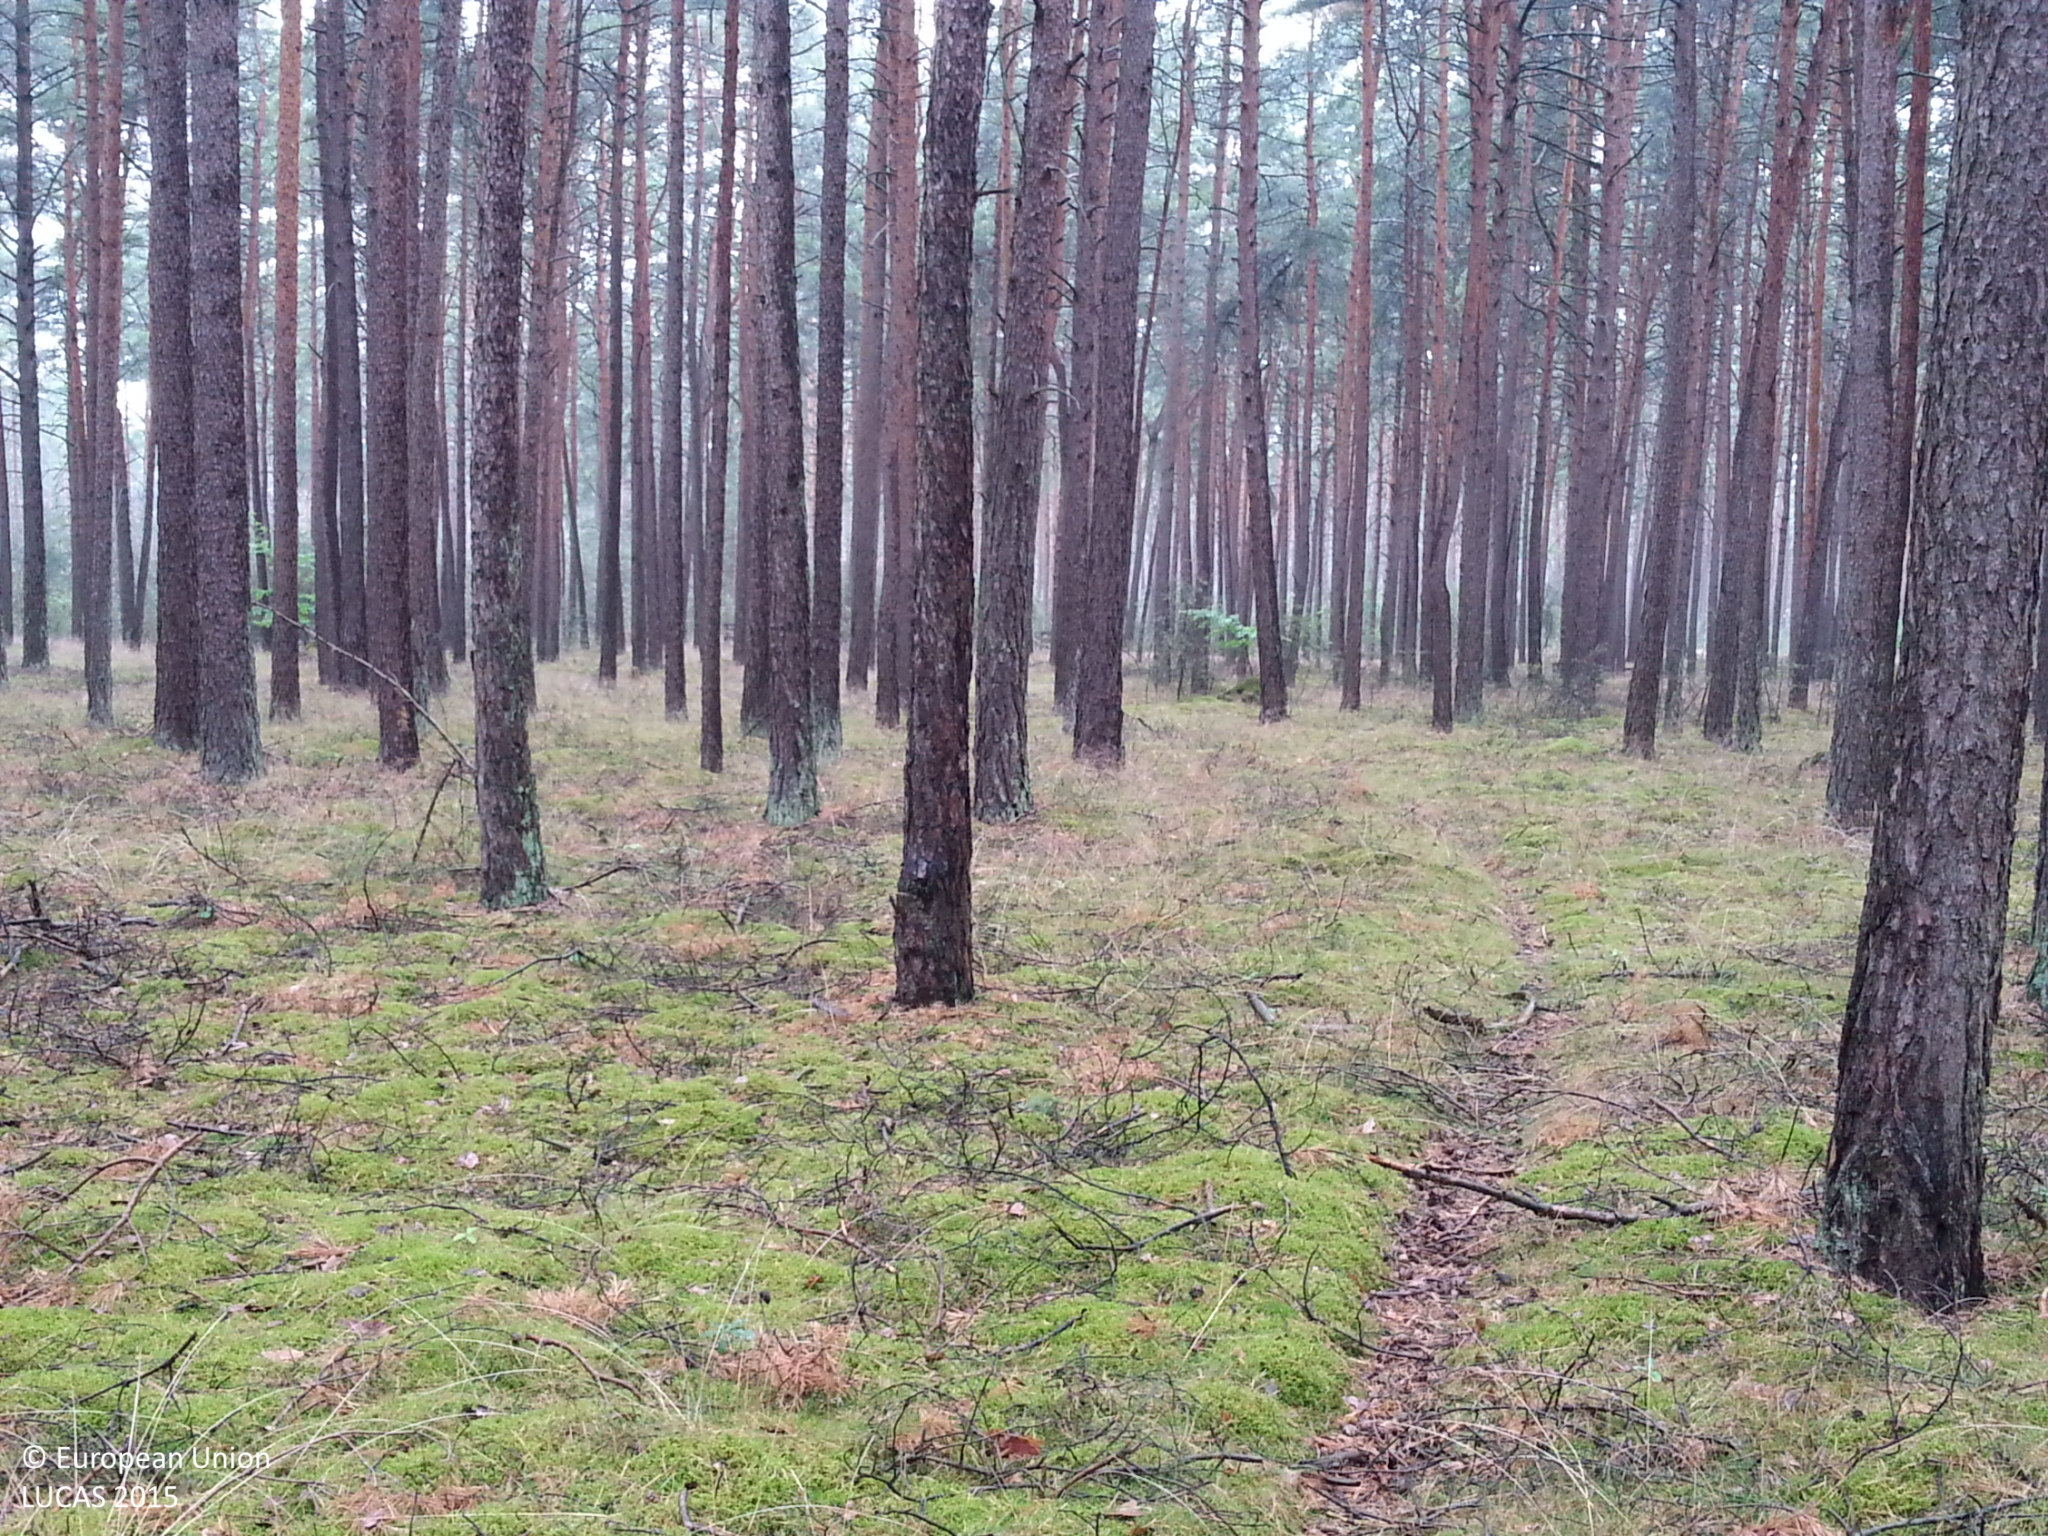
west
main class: Woodland
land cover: Pine dominated coniferous woodland
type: hemiboreal forest and nemoral coniferous forest and mixed broadleaved-coniferous forest
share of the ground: > 75 %
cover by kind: coniferous forest trees 75 %, herbaceous plants 25 %
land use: Forestry
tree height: > 5 m
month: July
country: DE
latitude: 52.9842
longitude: 11.0274
